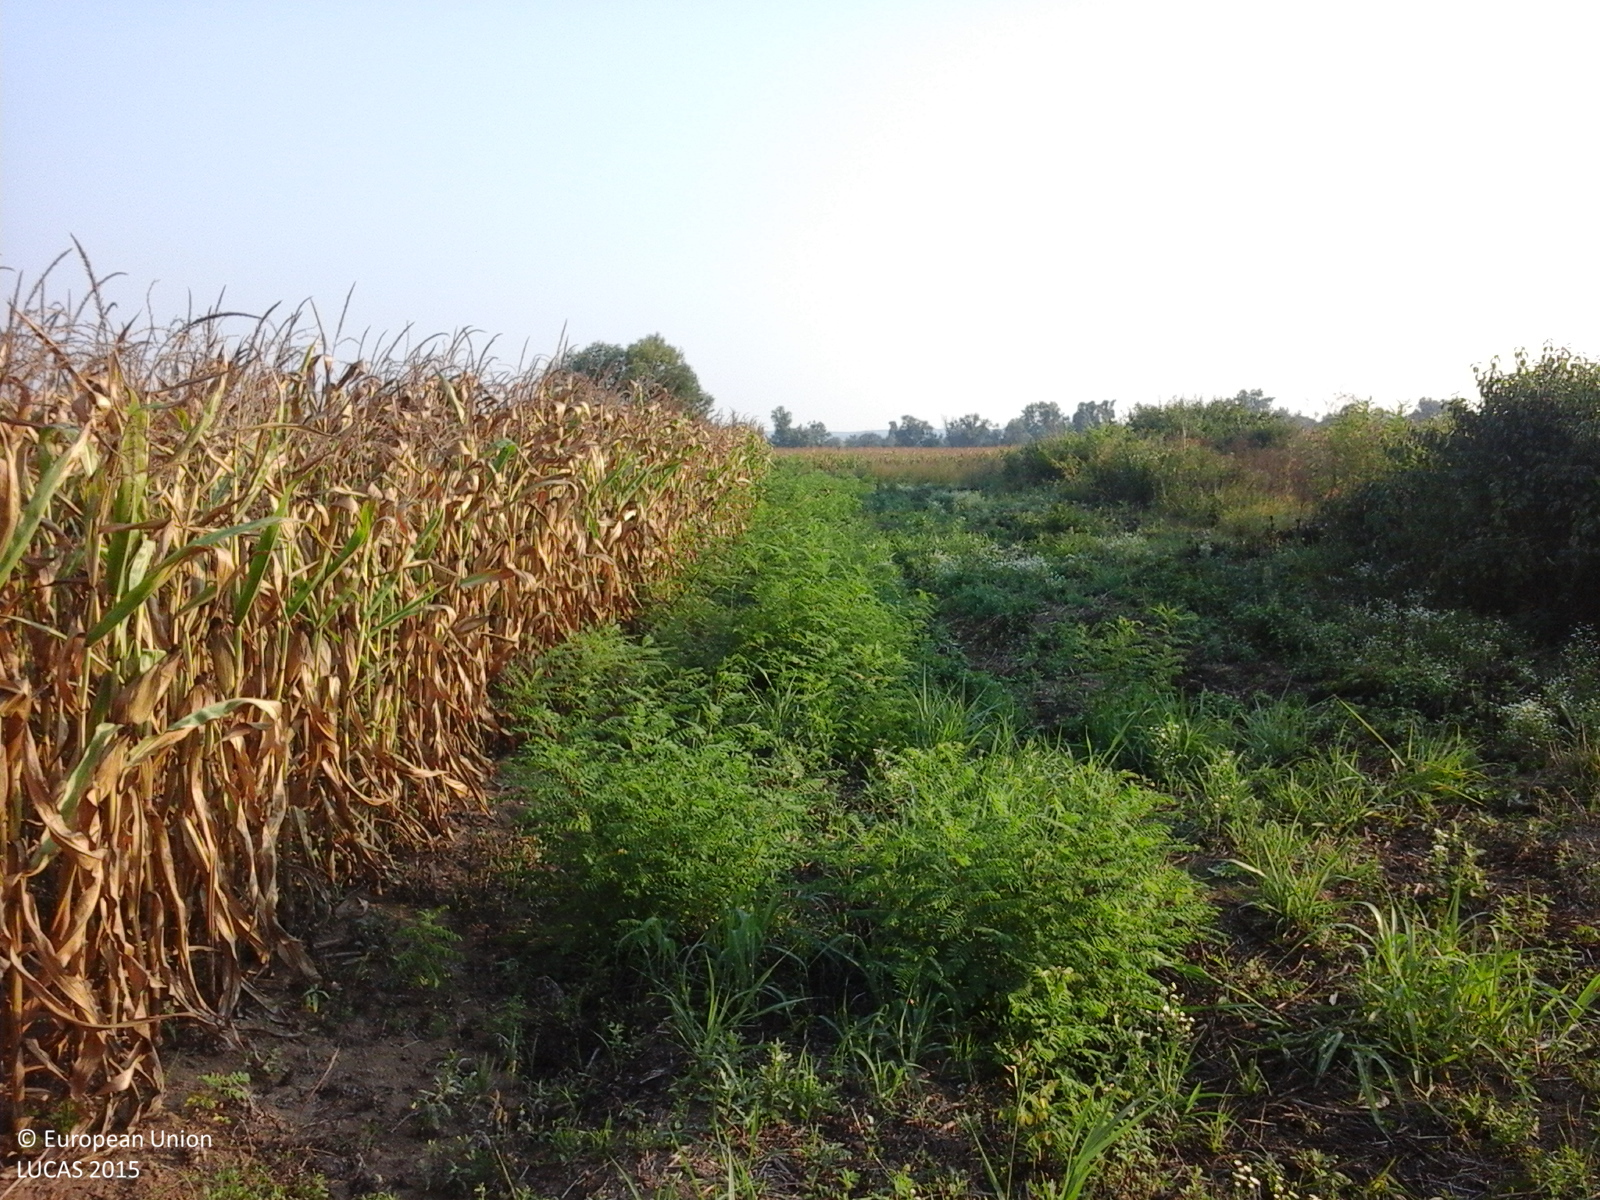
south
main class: Cropland
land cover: Maize
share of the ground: > 75 %
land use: Agriculture (excluding fallow land and kitchen gardens)
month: August
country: RO
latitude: 46.0260
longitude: 22.0959
